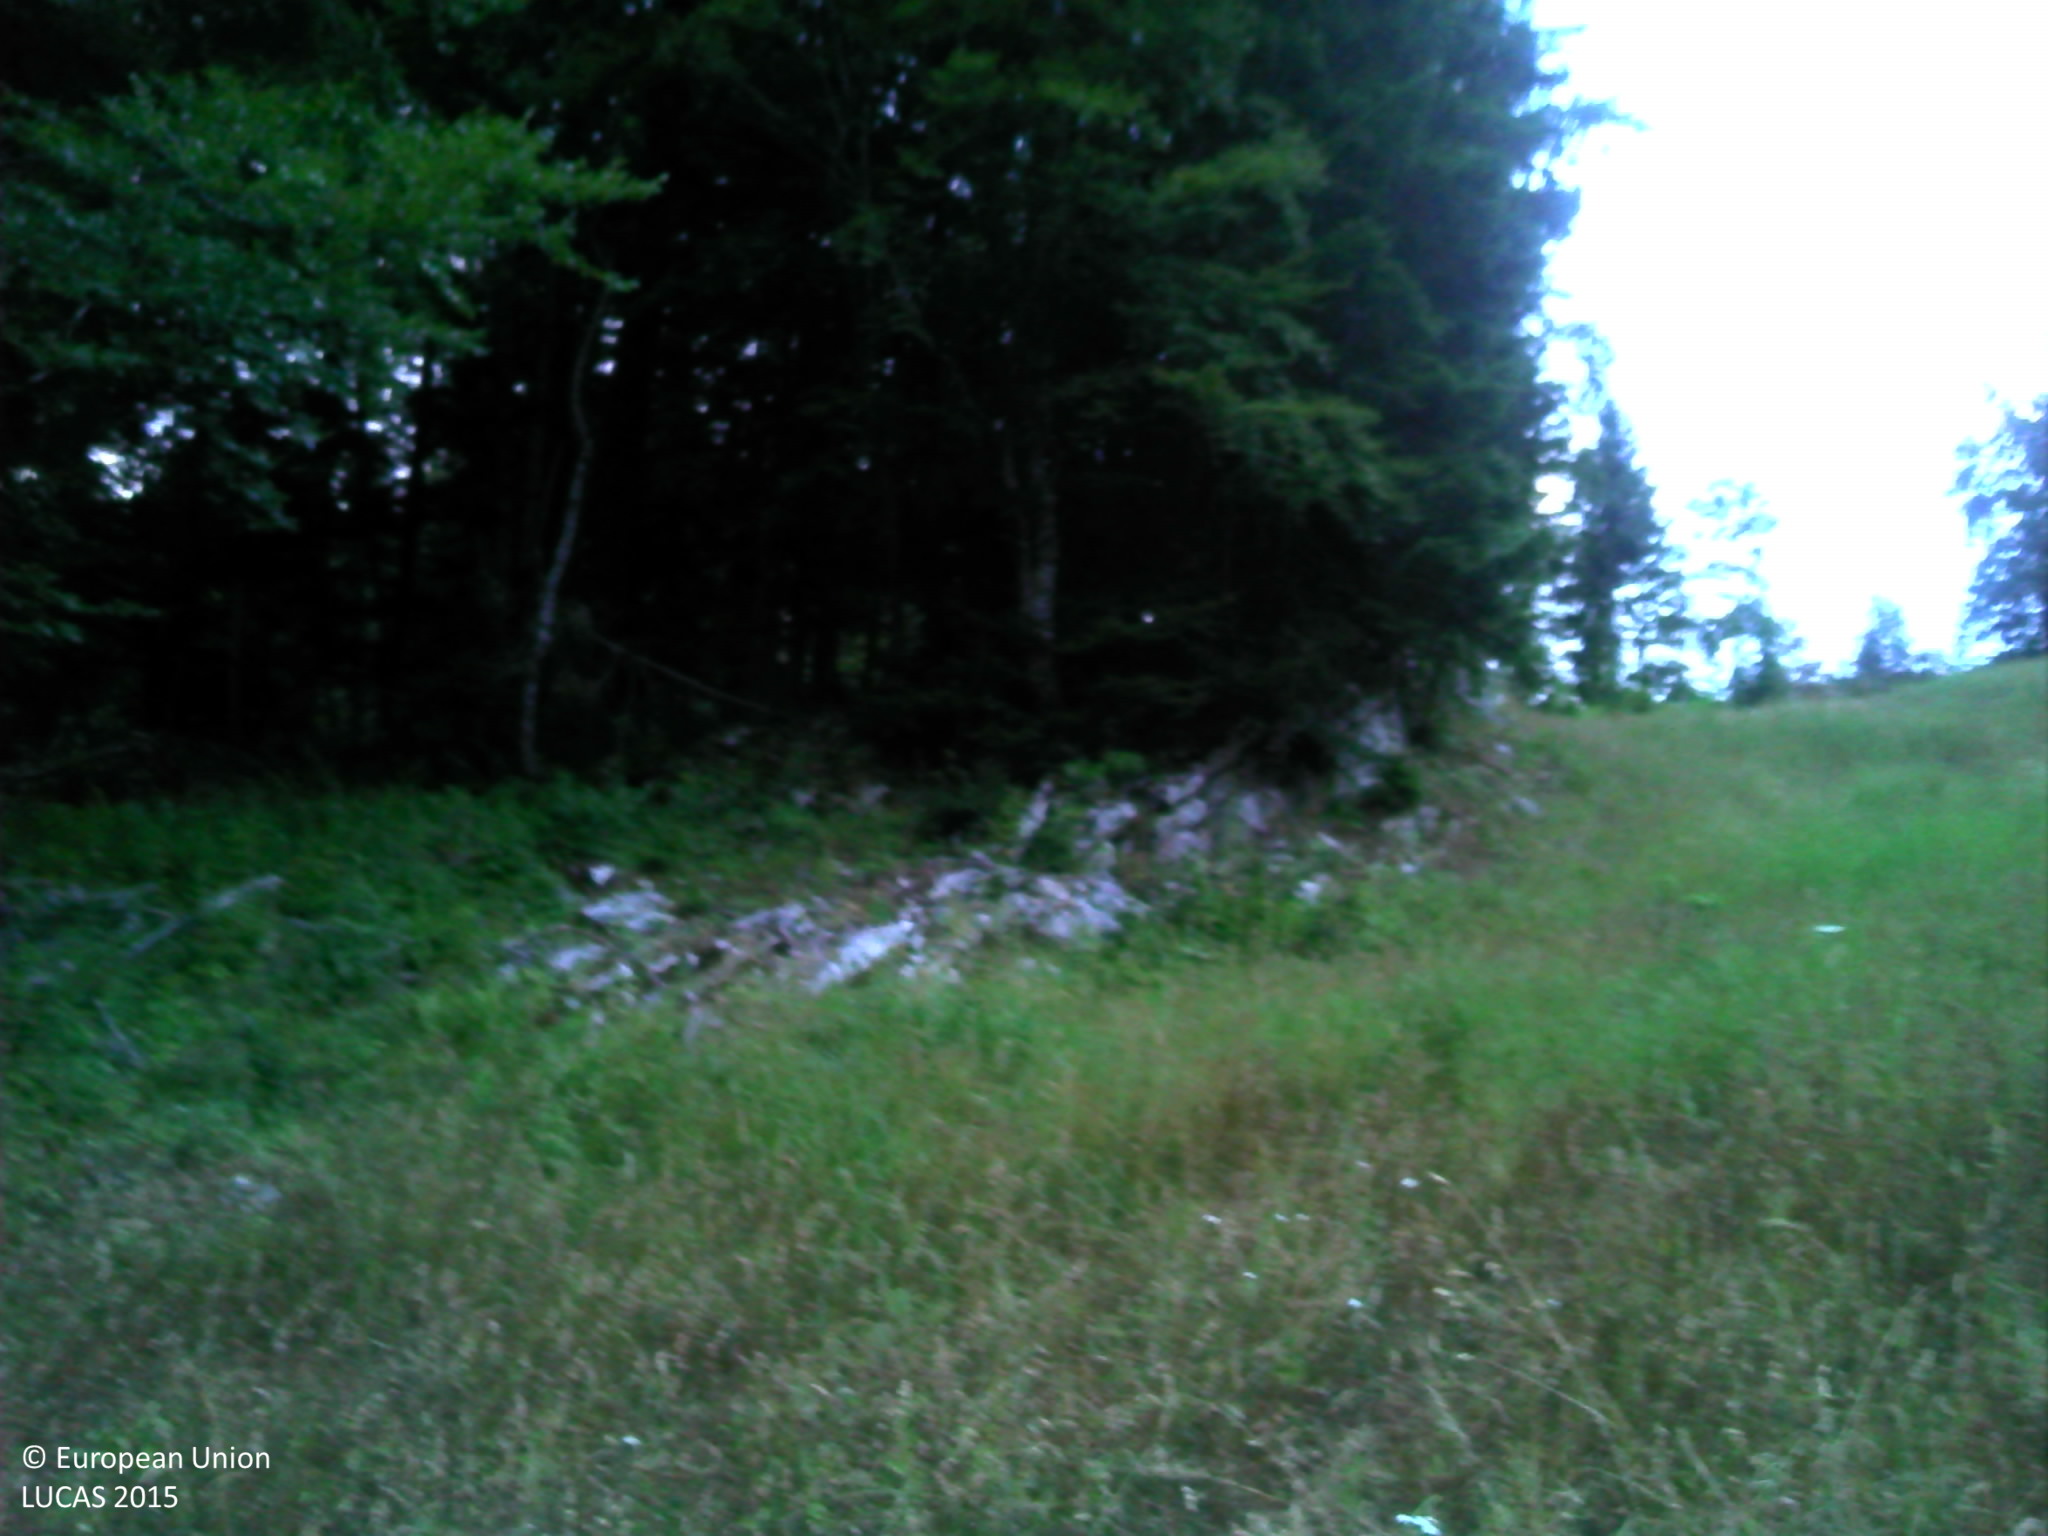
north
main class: Grassland
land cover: Grassland without tree/shrub cover
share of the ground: > 75 %
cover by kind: herbaceous plants 100 %
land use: Agriculture (excluding fallow land and kitchen gardens)
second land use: Sport
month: July
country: FR
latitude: 45.2316
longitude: 5.5854
